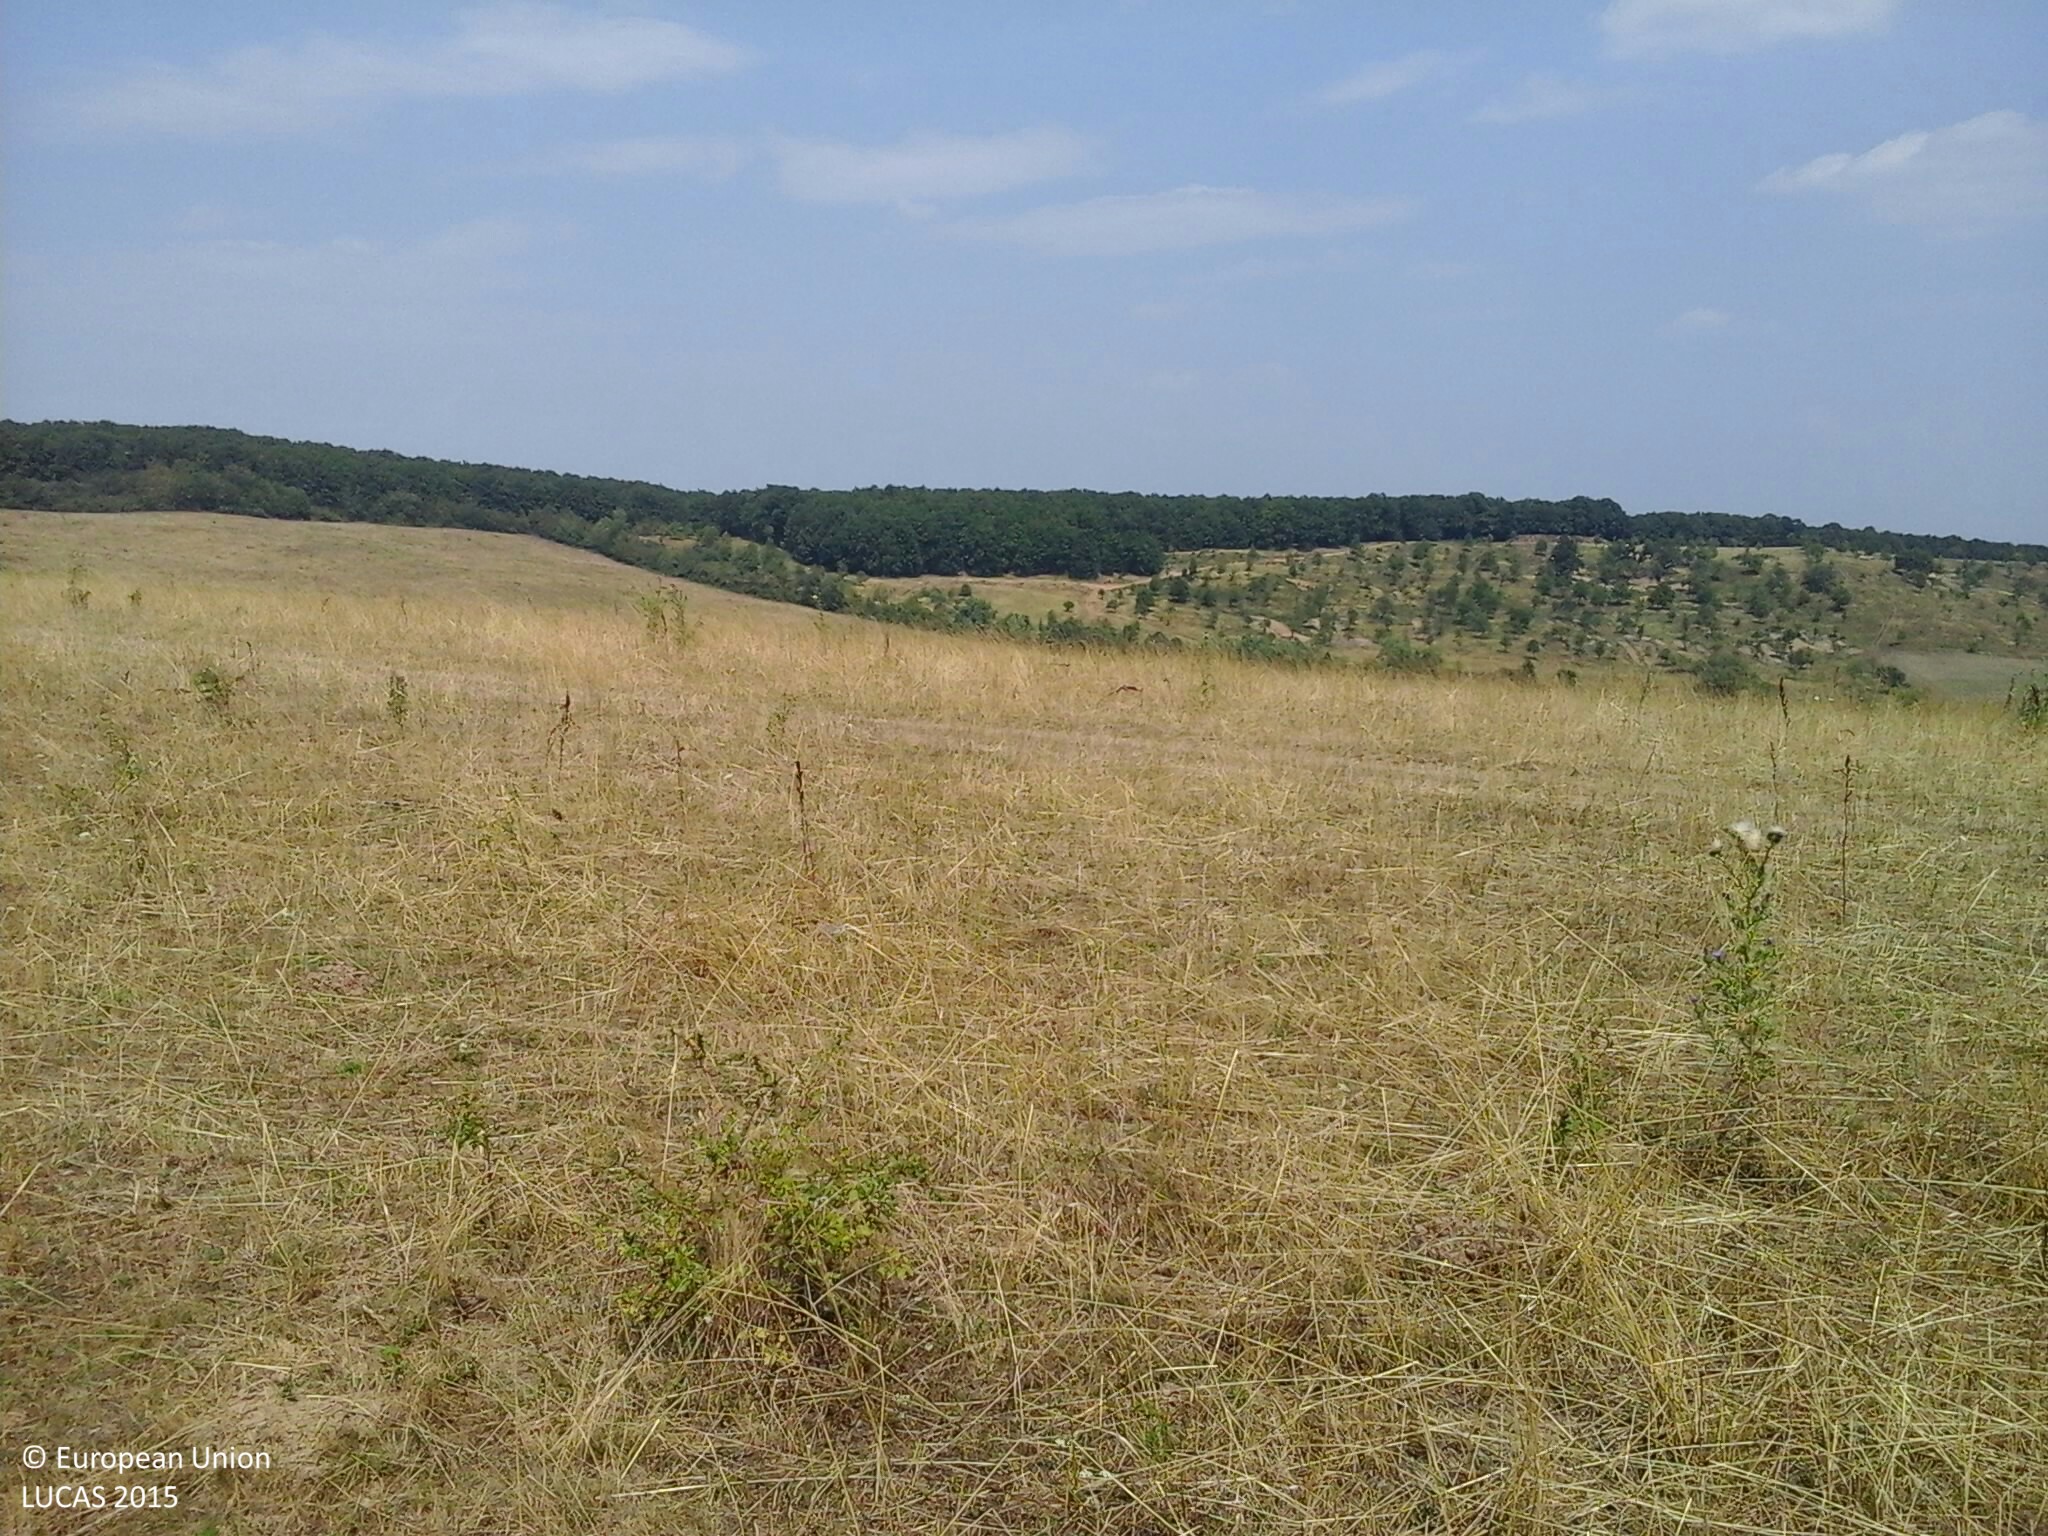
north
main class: Grassland
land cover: Grassland without tree/shrub cover
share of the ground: > 75 %
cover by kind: herbaceous plants 100 %
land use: Agriculture (excluding fallow land and kitchen gardens)
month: August
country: HU
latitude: 48.4071
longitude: 20.5314
